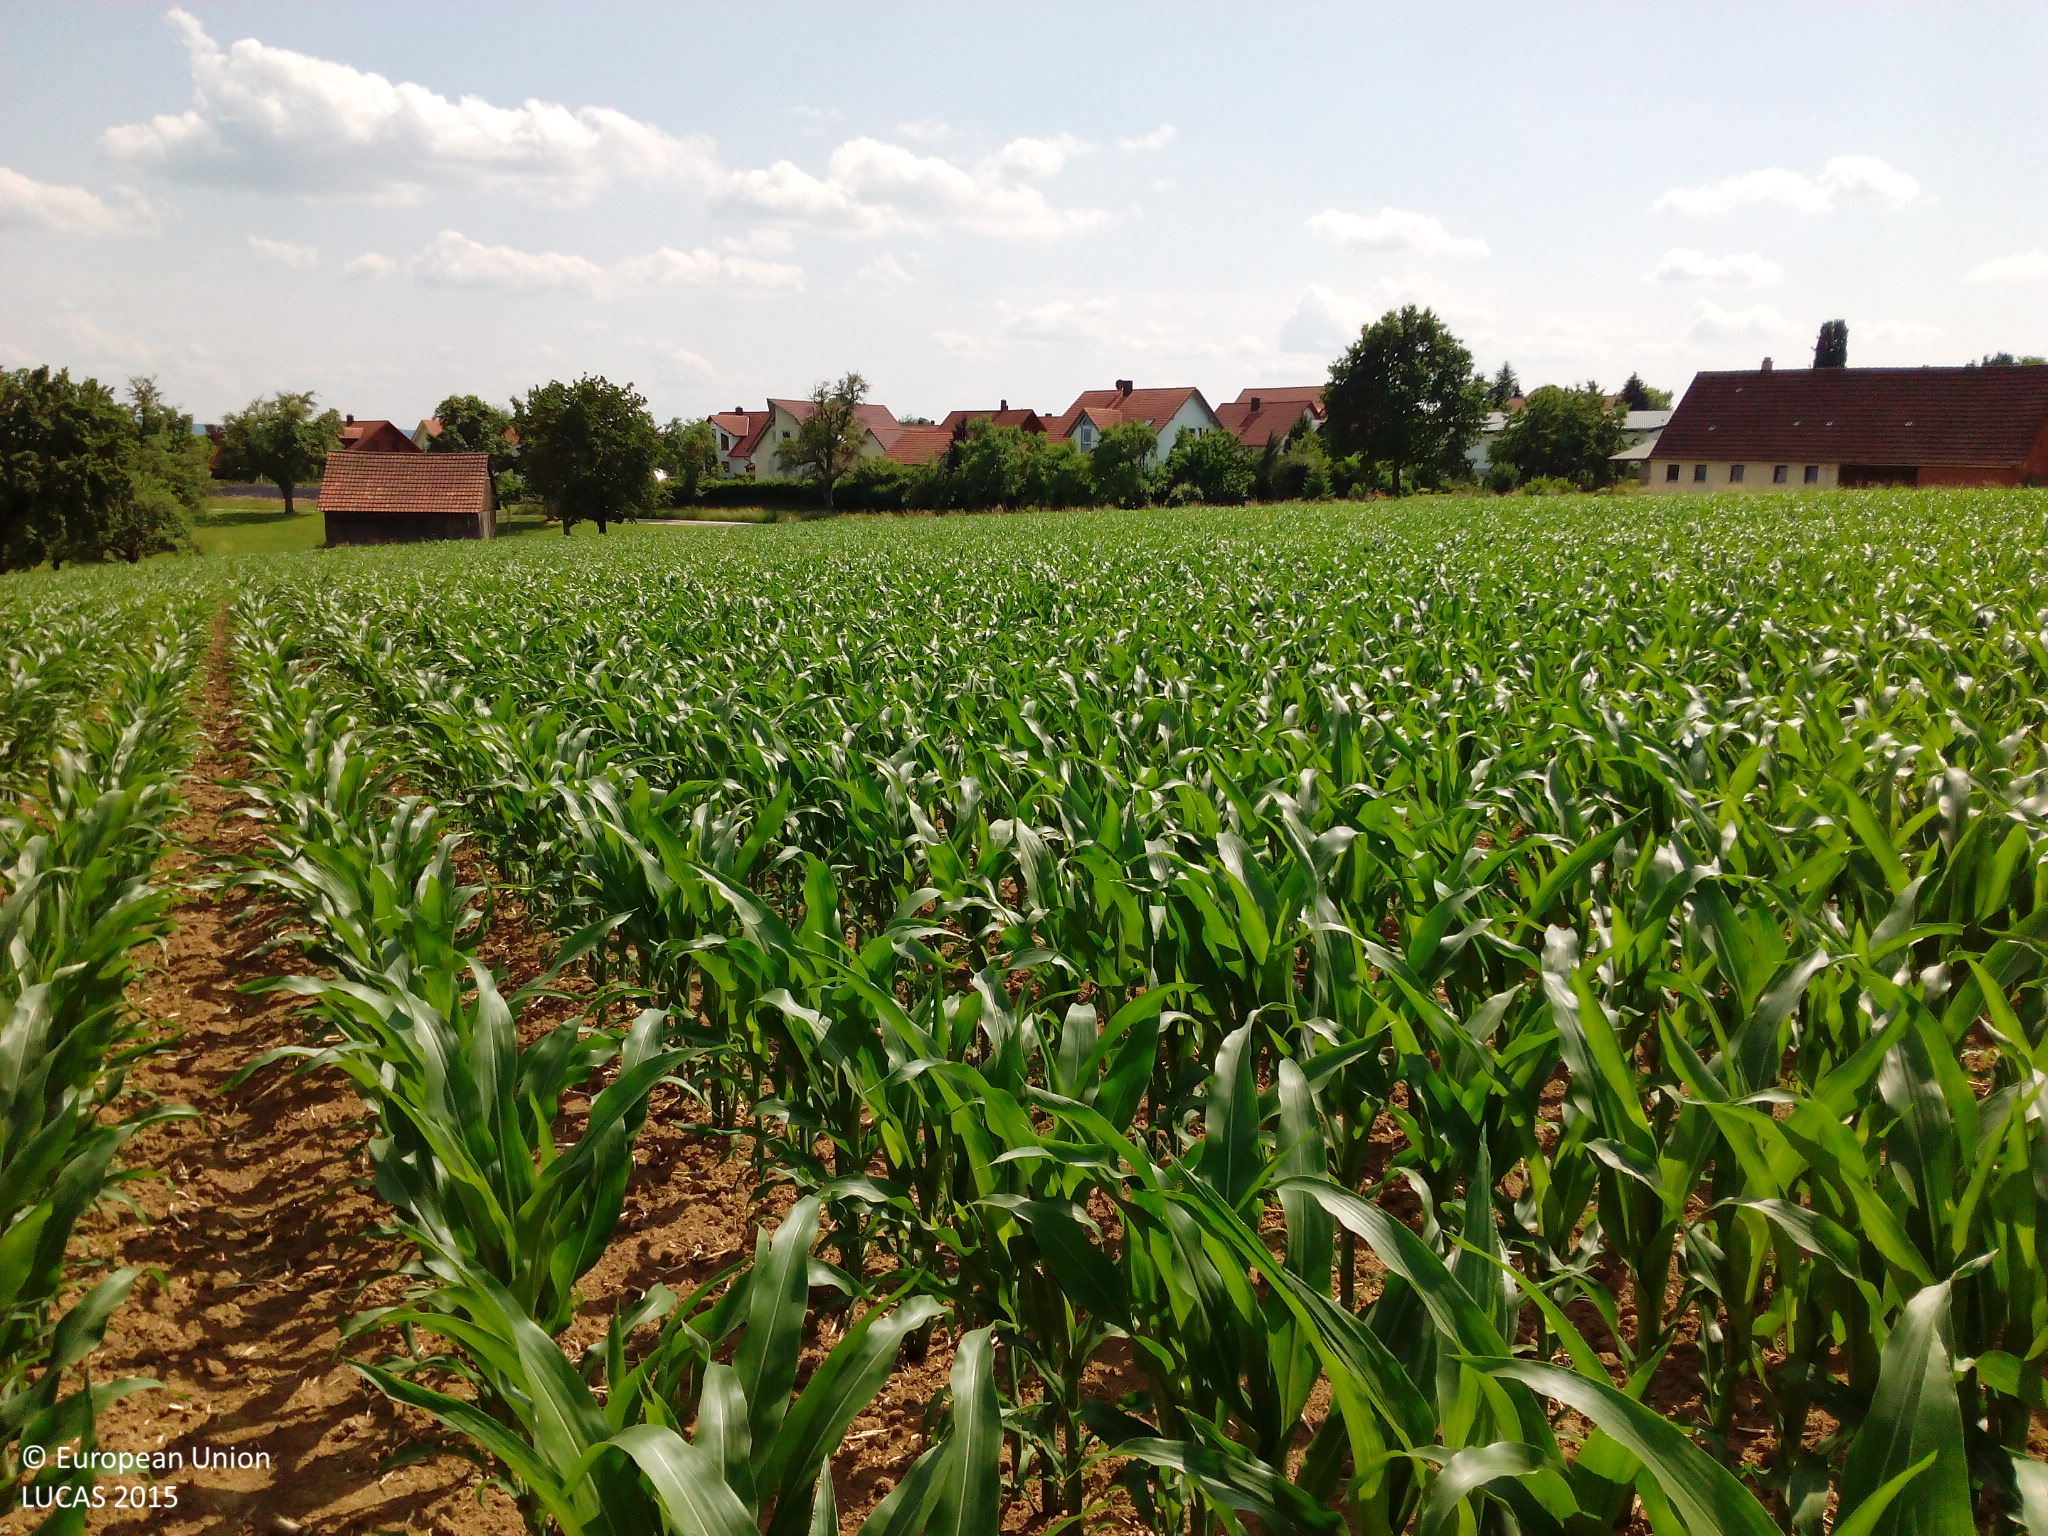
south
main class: Cropland
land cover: Maize
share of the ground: > 75 %
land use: Agriculture (excluding fallow land and kitchen gardens)
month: June
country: DE
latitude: 49.2662
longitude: 9.5742
